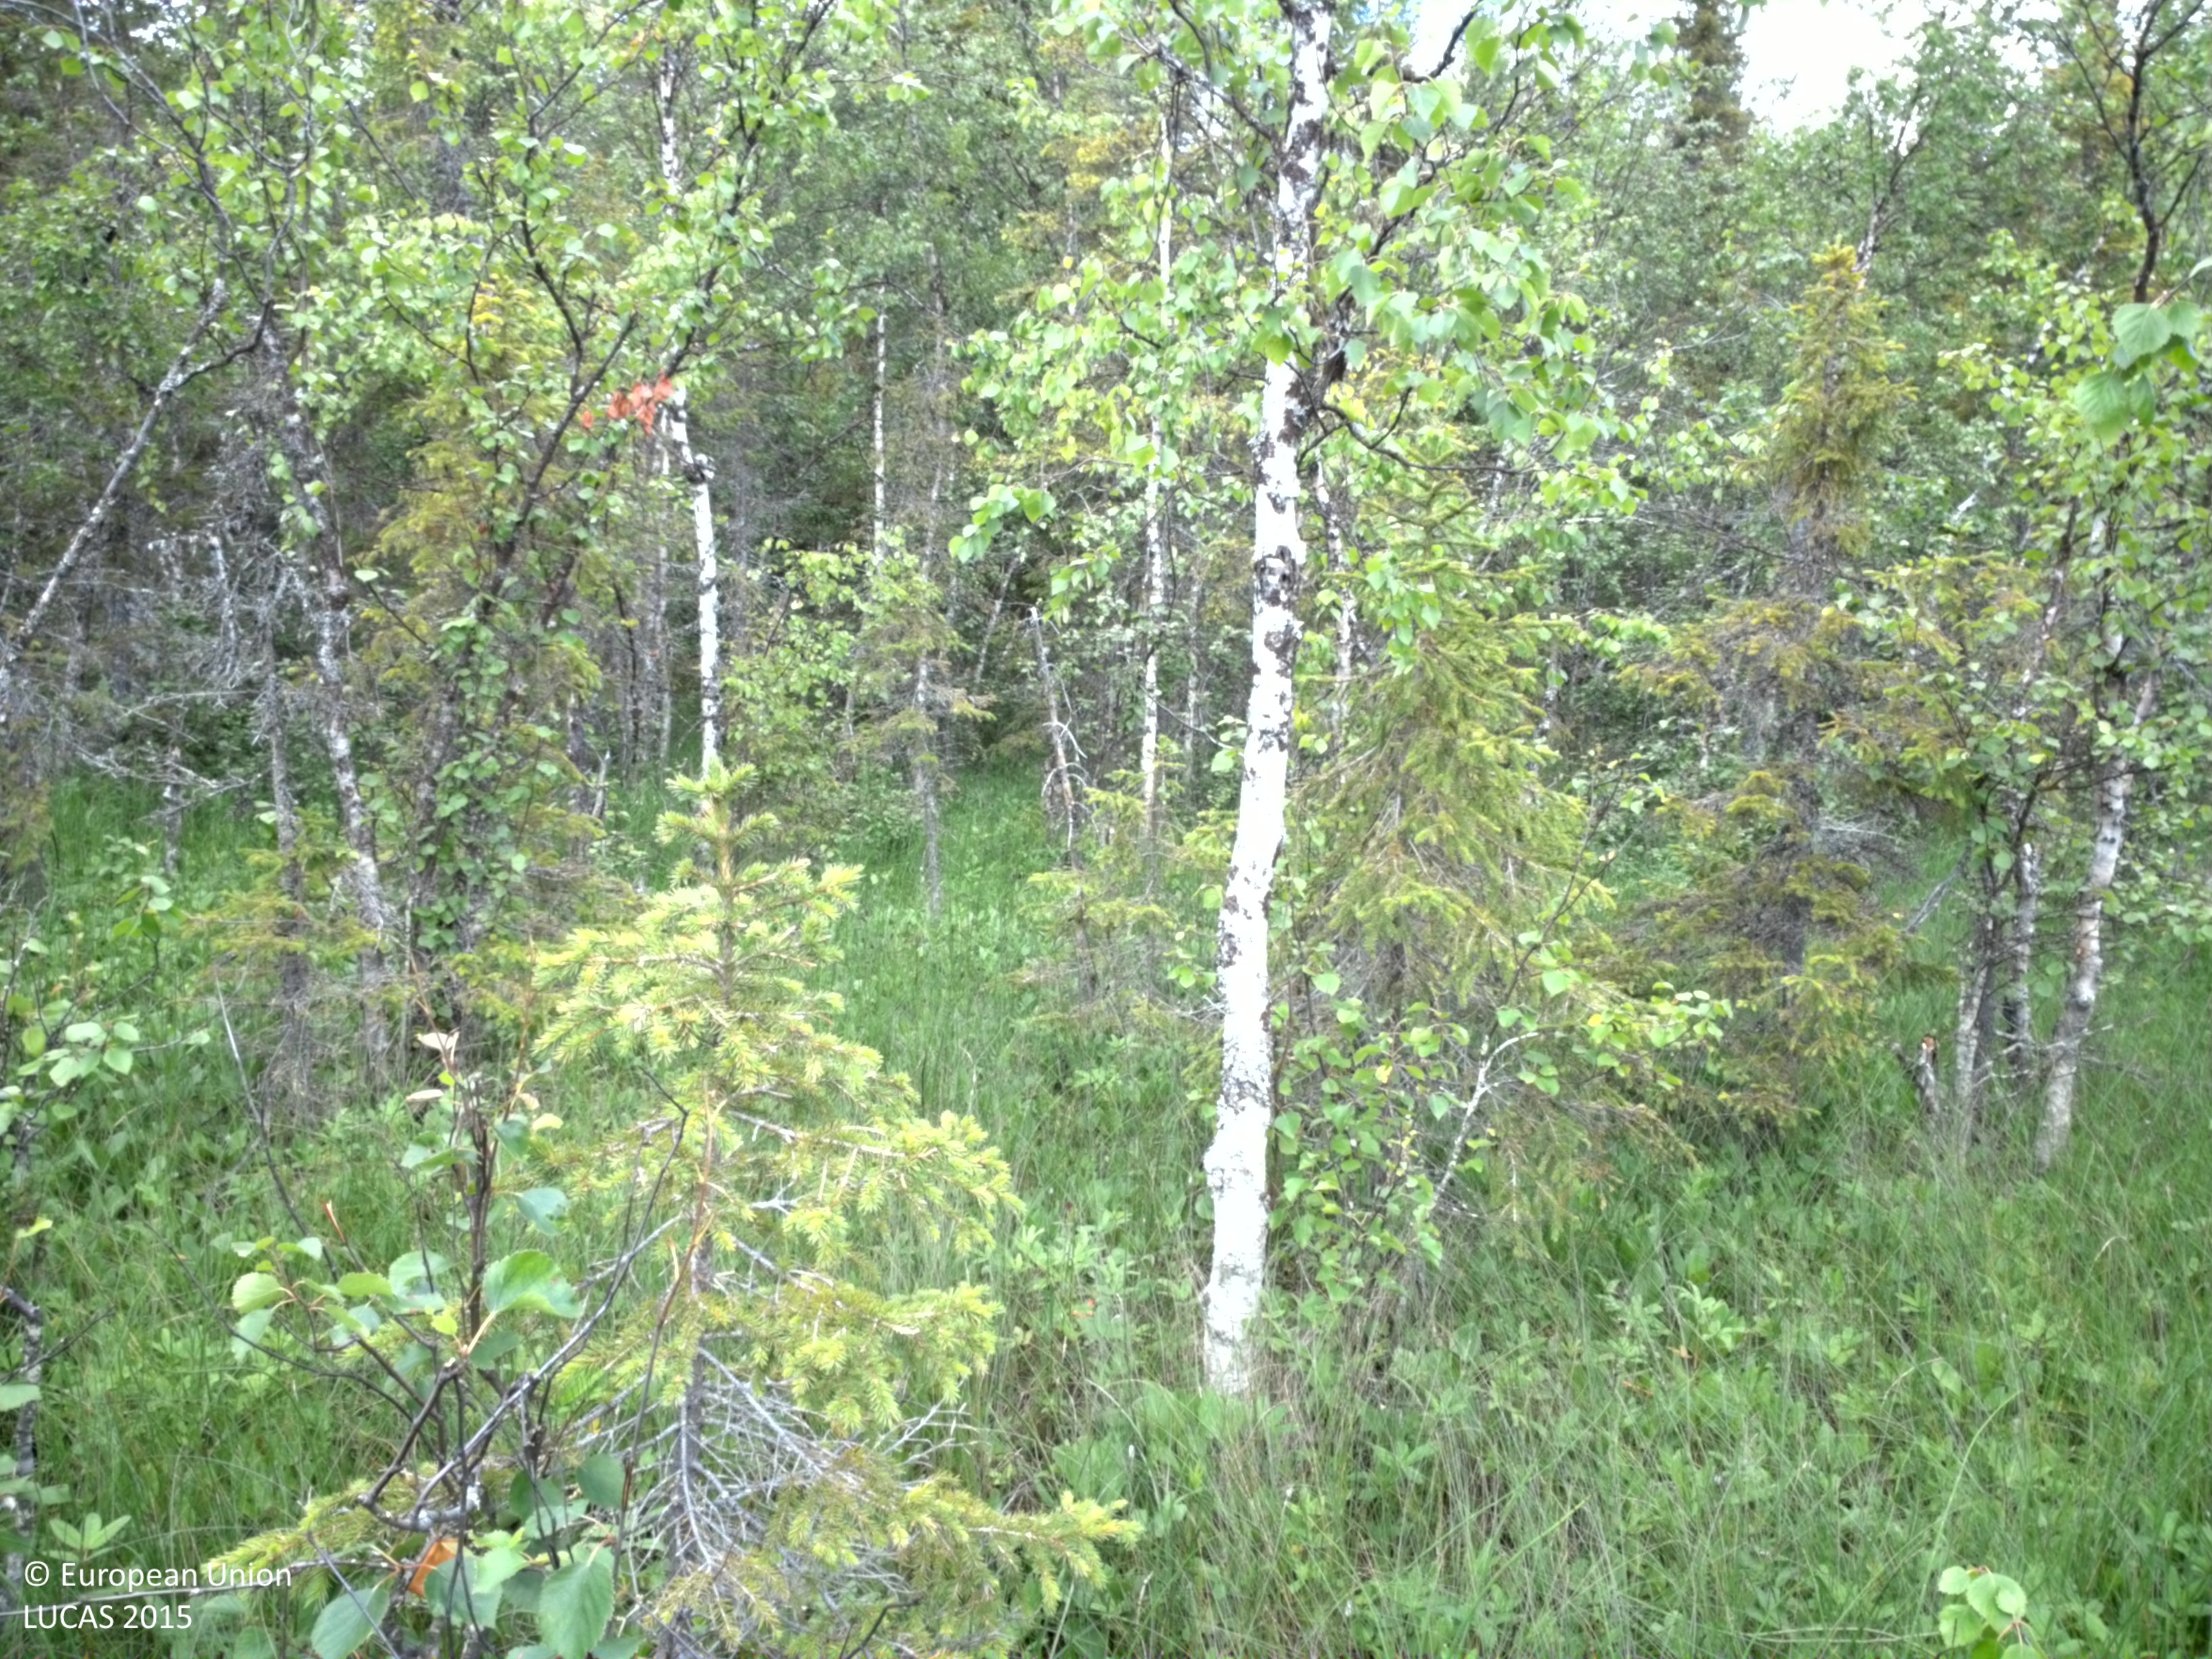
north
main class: Woodland
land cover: Broadleaved woodland
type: mire and swamp forests
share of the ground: 25 - 50 %
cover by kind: herbaceous plants 45 %, broadleaved forest trees 30 %, shrubs 10 %, coniferous forest trees 5 %
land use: Semi-natural and natural areas not in use
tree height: < 5 m
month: August
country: SE
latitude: 66.5139
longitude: 20.8187
